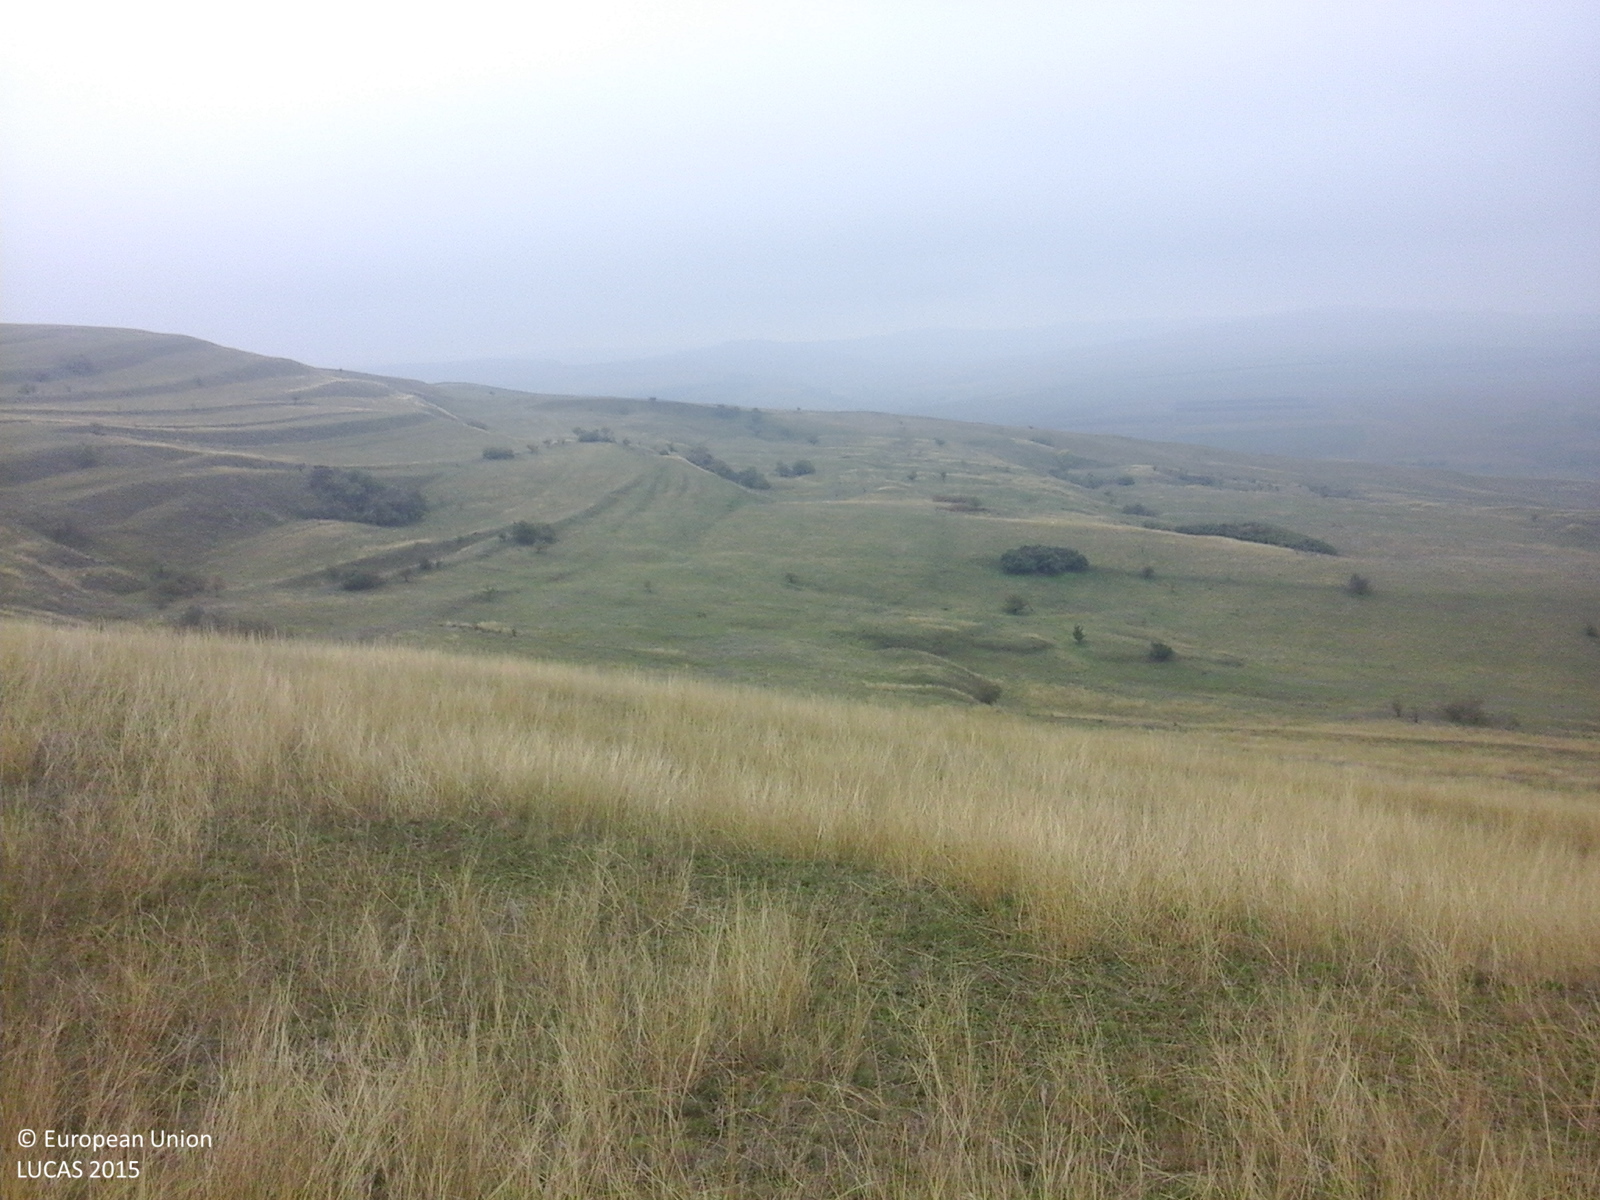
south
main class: Grassland
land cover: Grassland without tree/shrub cover
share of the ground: > 75 %
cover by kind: herbaceous plants 100 %
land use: Agriculture (excluding fallow land and kitchen gardens)
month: October
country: RO
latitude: 46.0539
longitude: 23.9413
